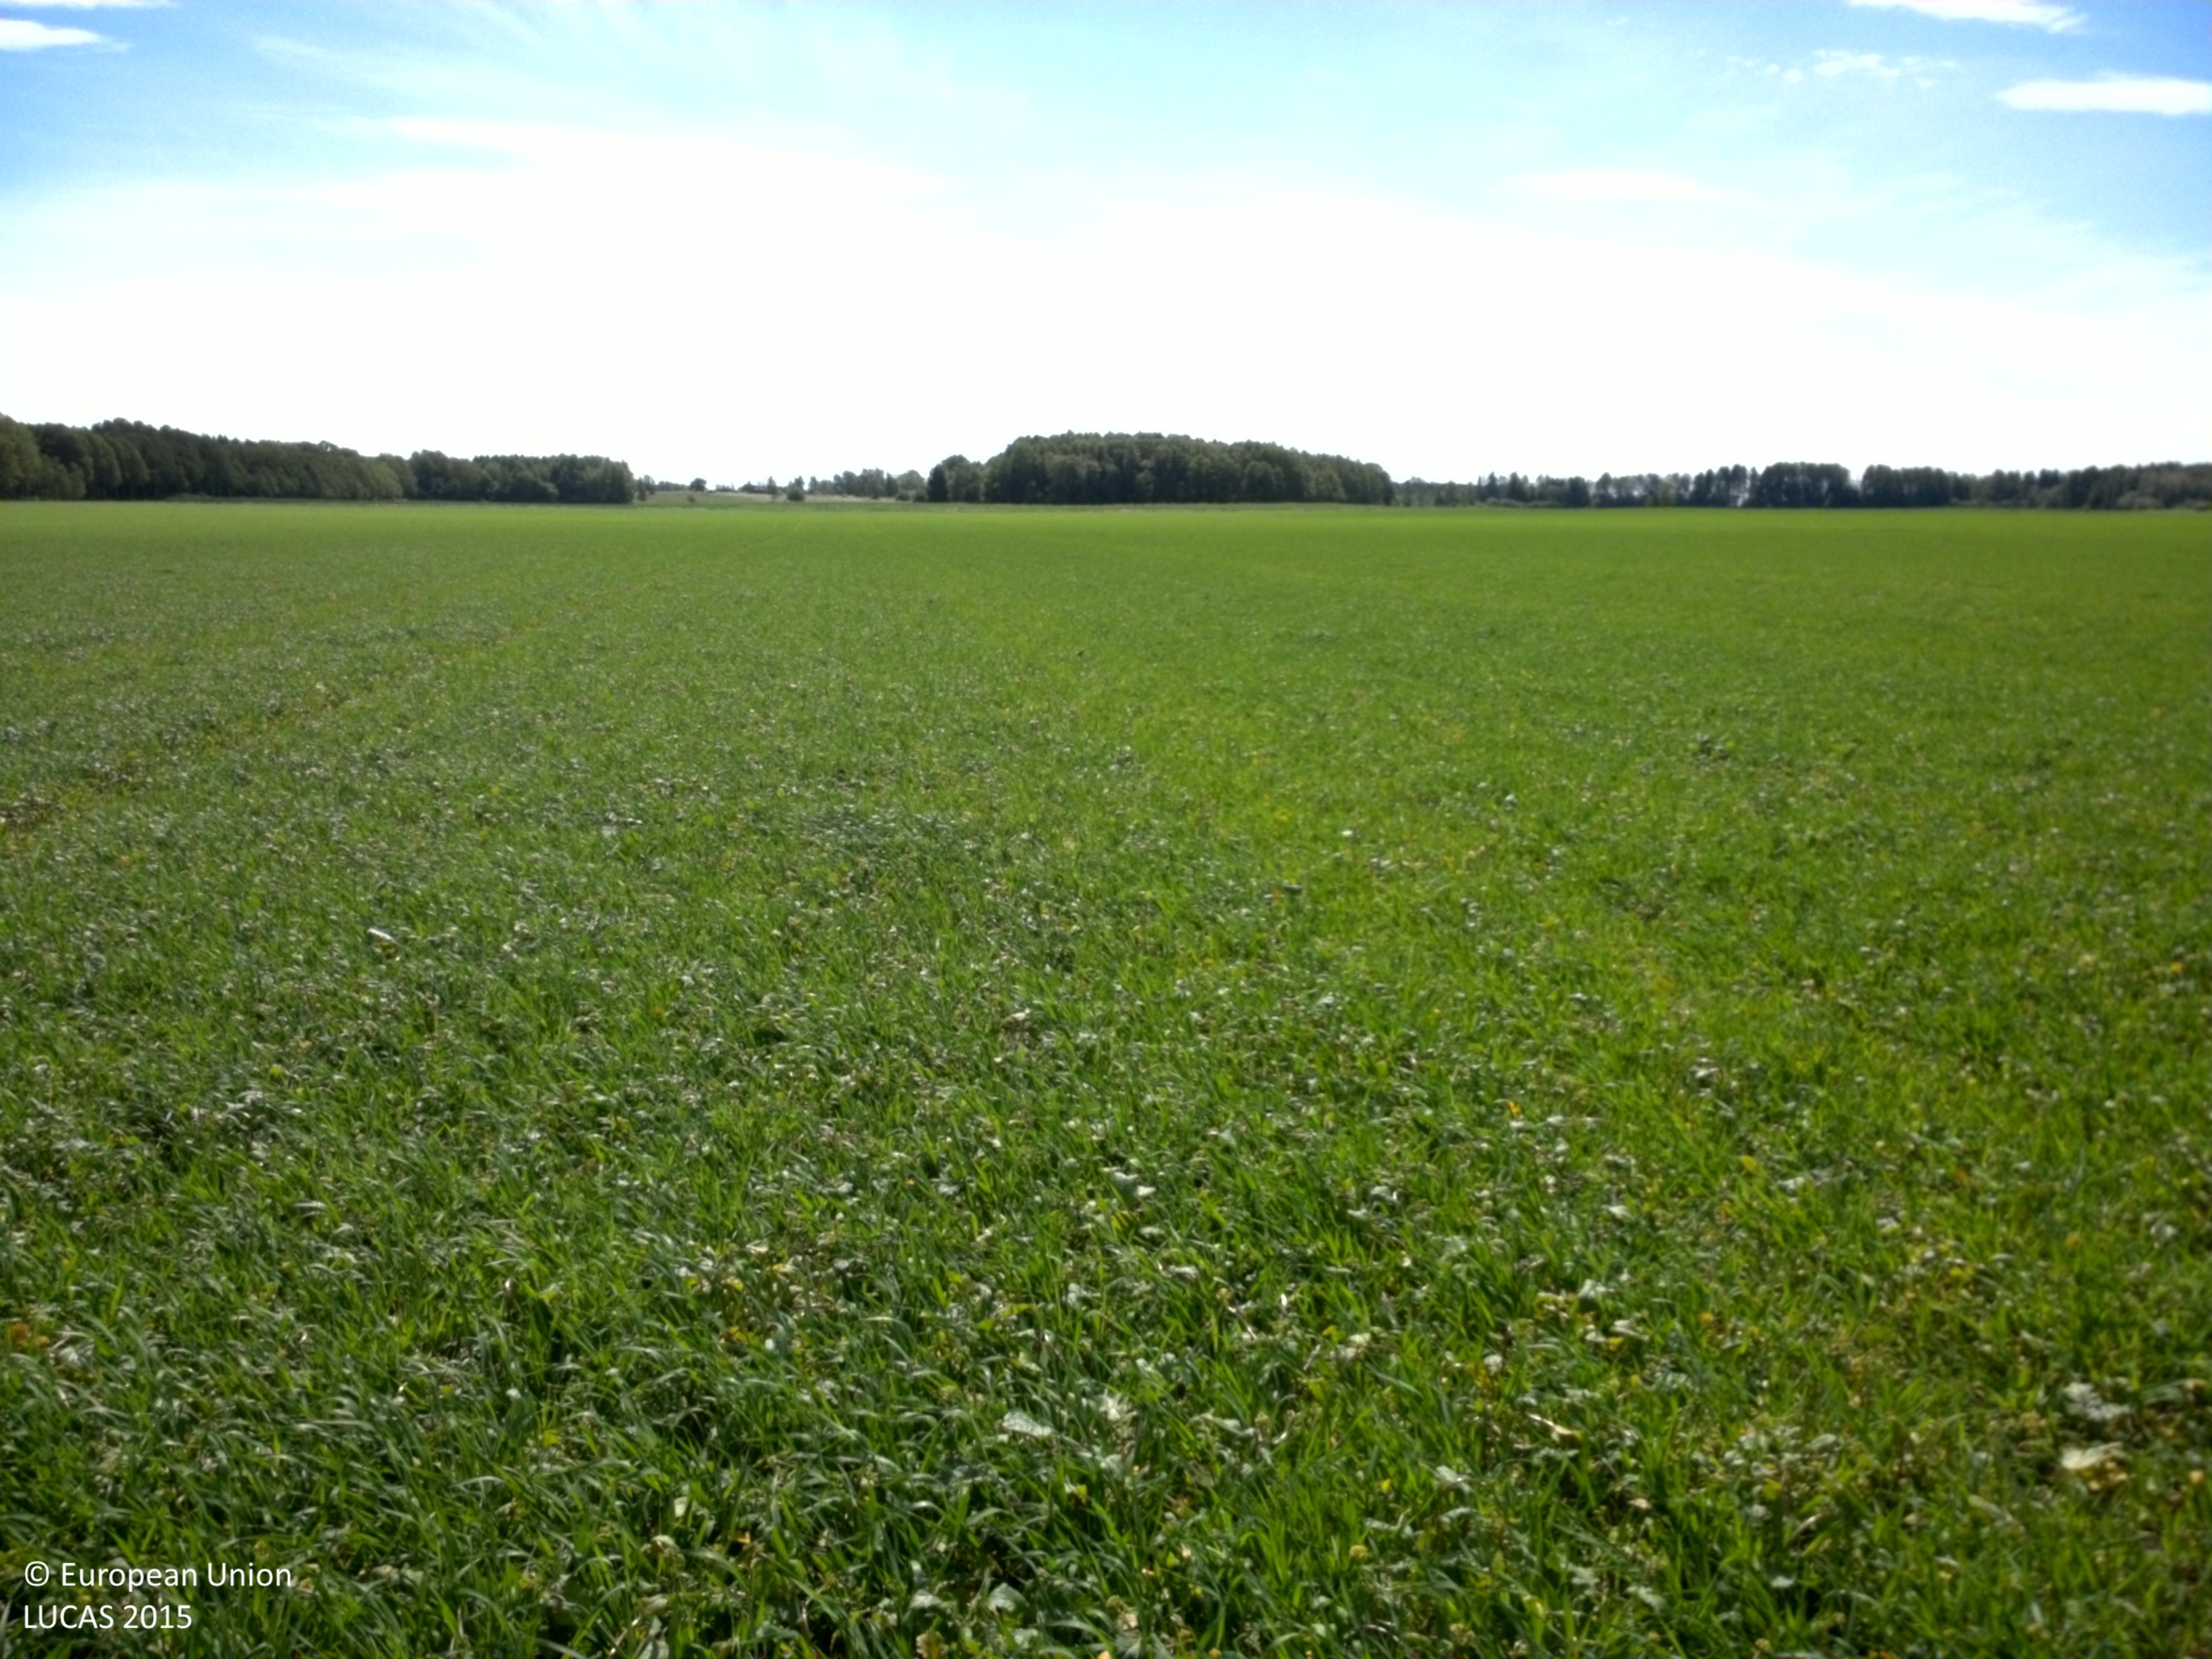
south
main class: Cropland
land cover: Barley
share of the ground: > 75 %
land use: Agriculture (excluding fallow land and kitchen gardens)
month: June
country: SE
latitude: 58.5257
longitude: 15.4031
